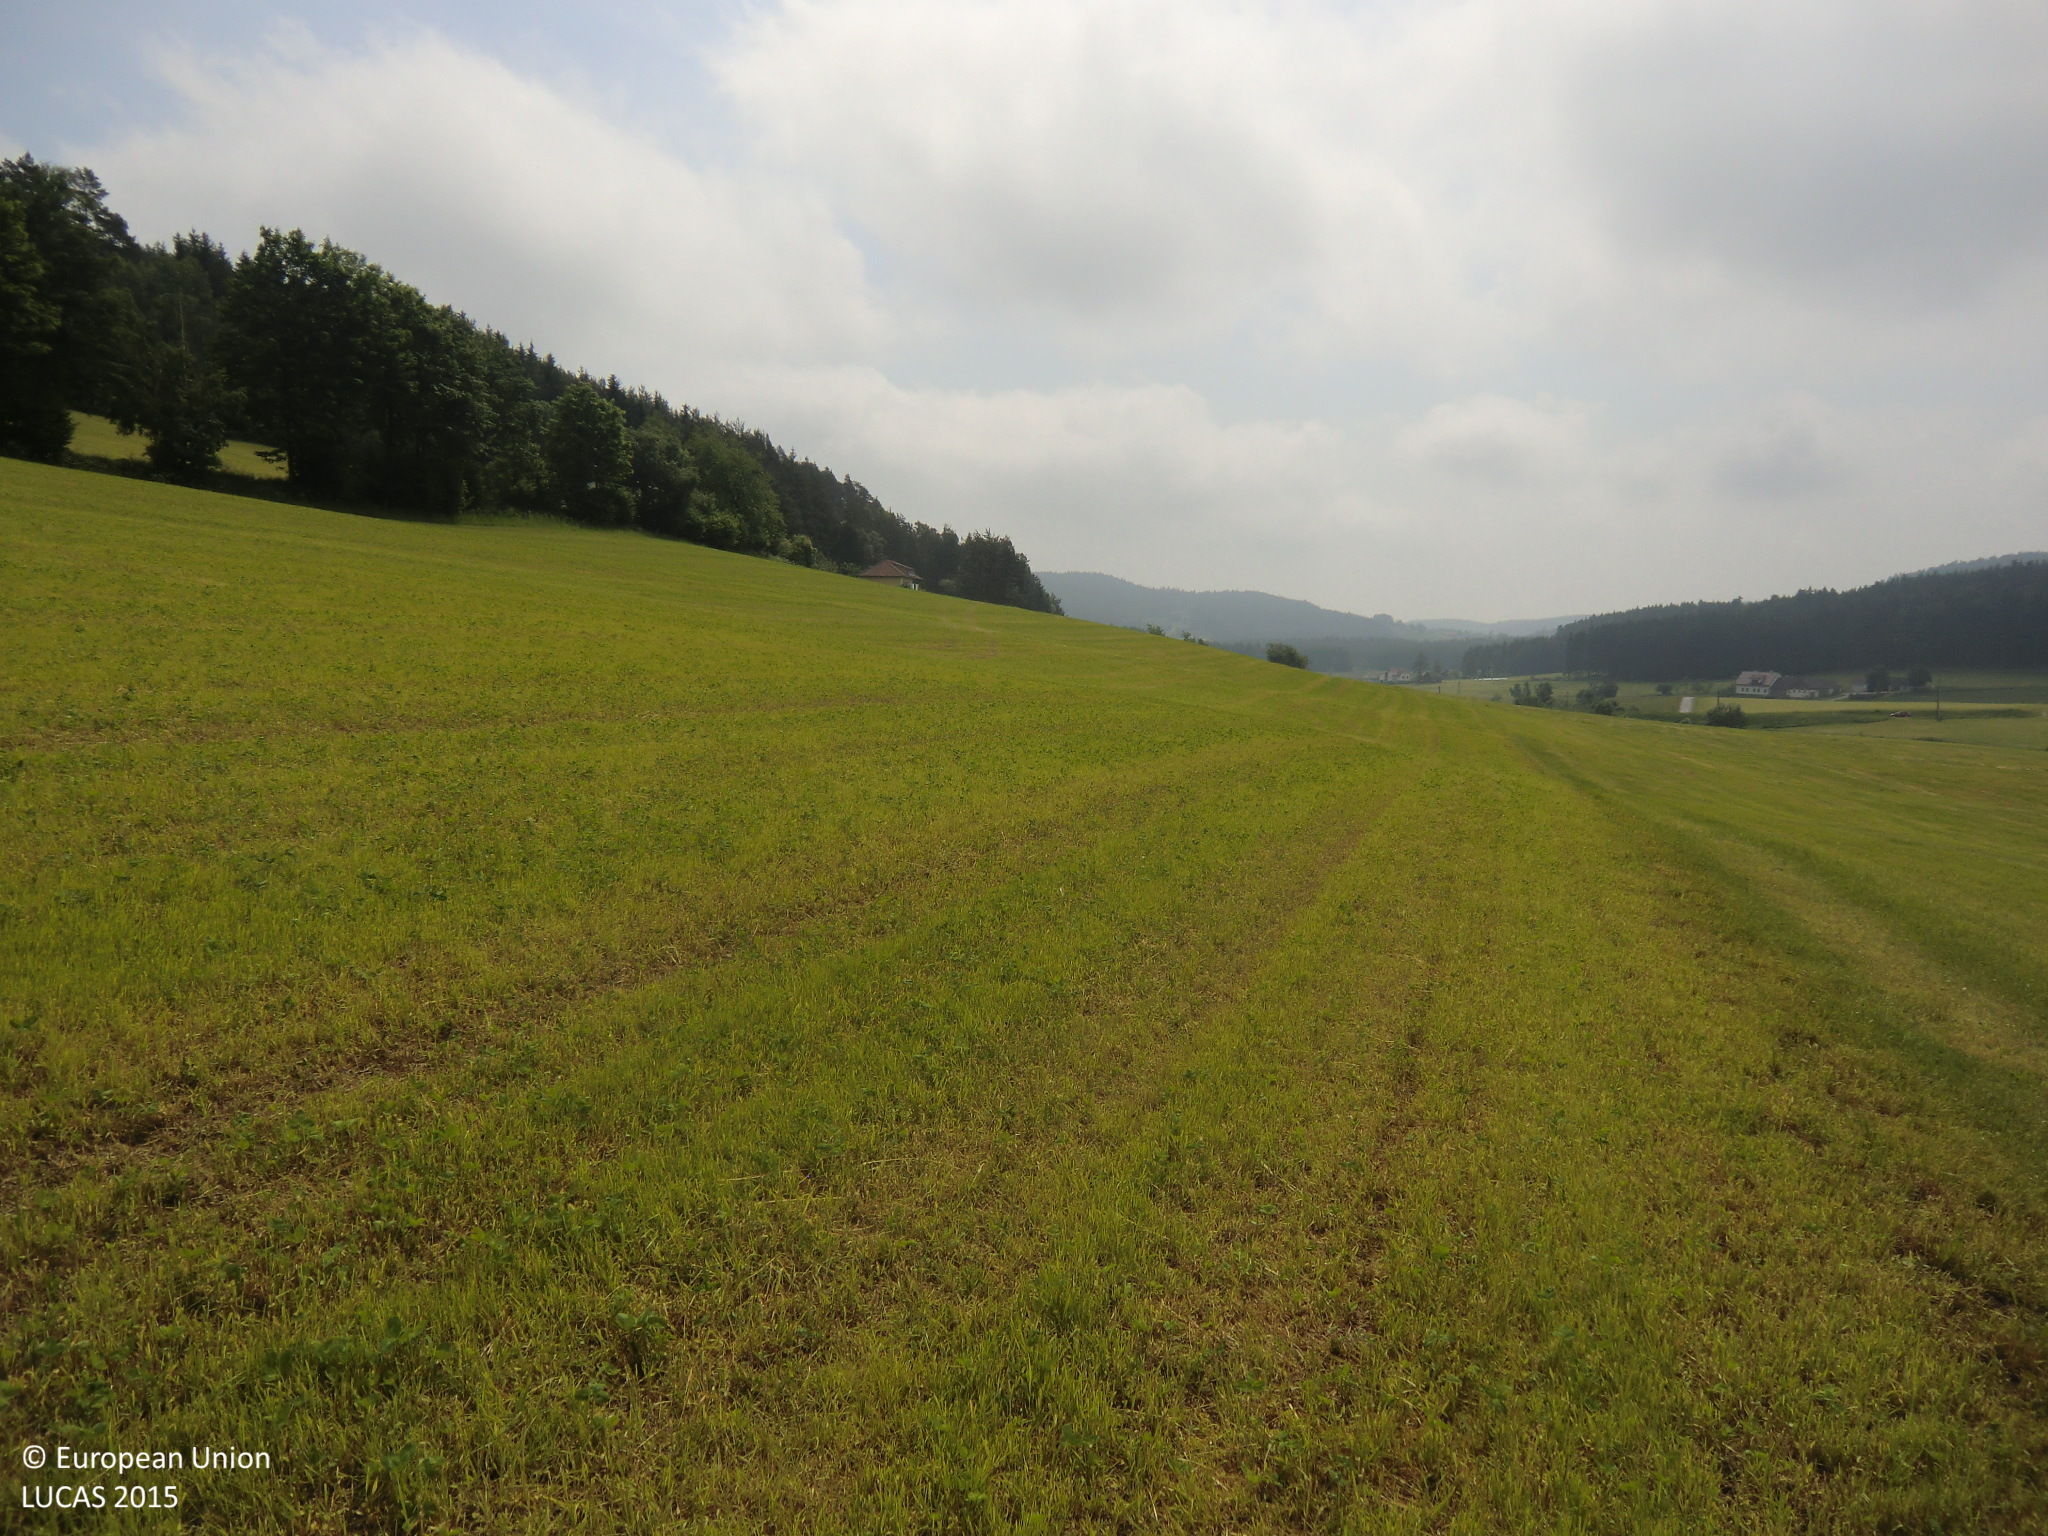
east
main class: Cropland
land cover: Temporary grasslands
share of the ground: > 75 %
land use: Agriculture (excluding fallow land and kitchen gardens)
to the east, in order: Temporary grasslands; Broadleaved woodland; Paved roads, cycling and walking lanes; Grassland without tree/shrub cover; Spruce dominated mixed woodland; Tracks; Pine dominated coniferous woodland; Spruce dominated coniferous woodland; Tracks; Spruce dominated coniferous woodland
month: June
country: AT
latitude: 48.5871
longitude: 14.8140
